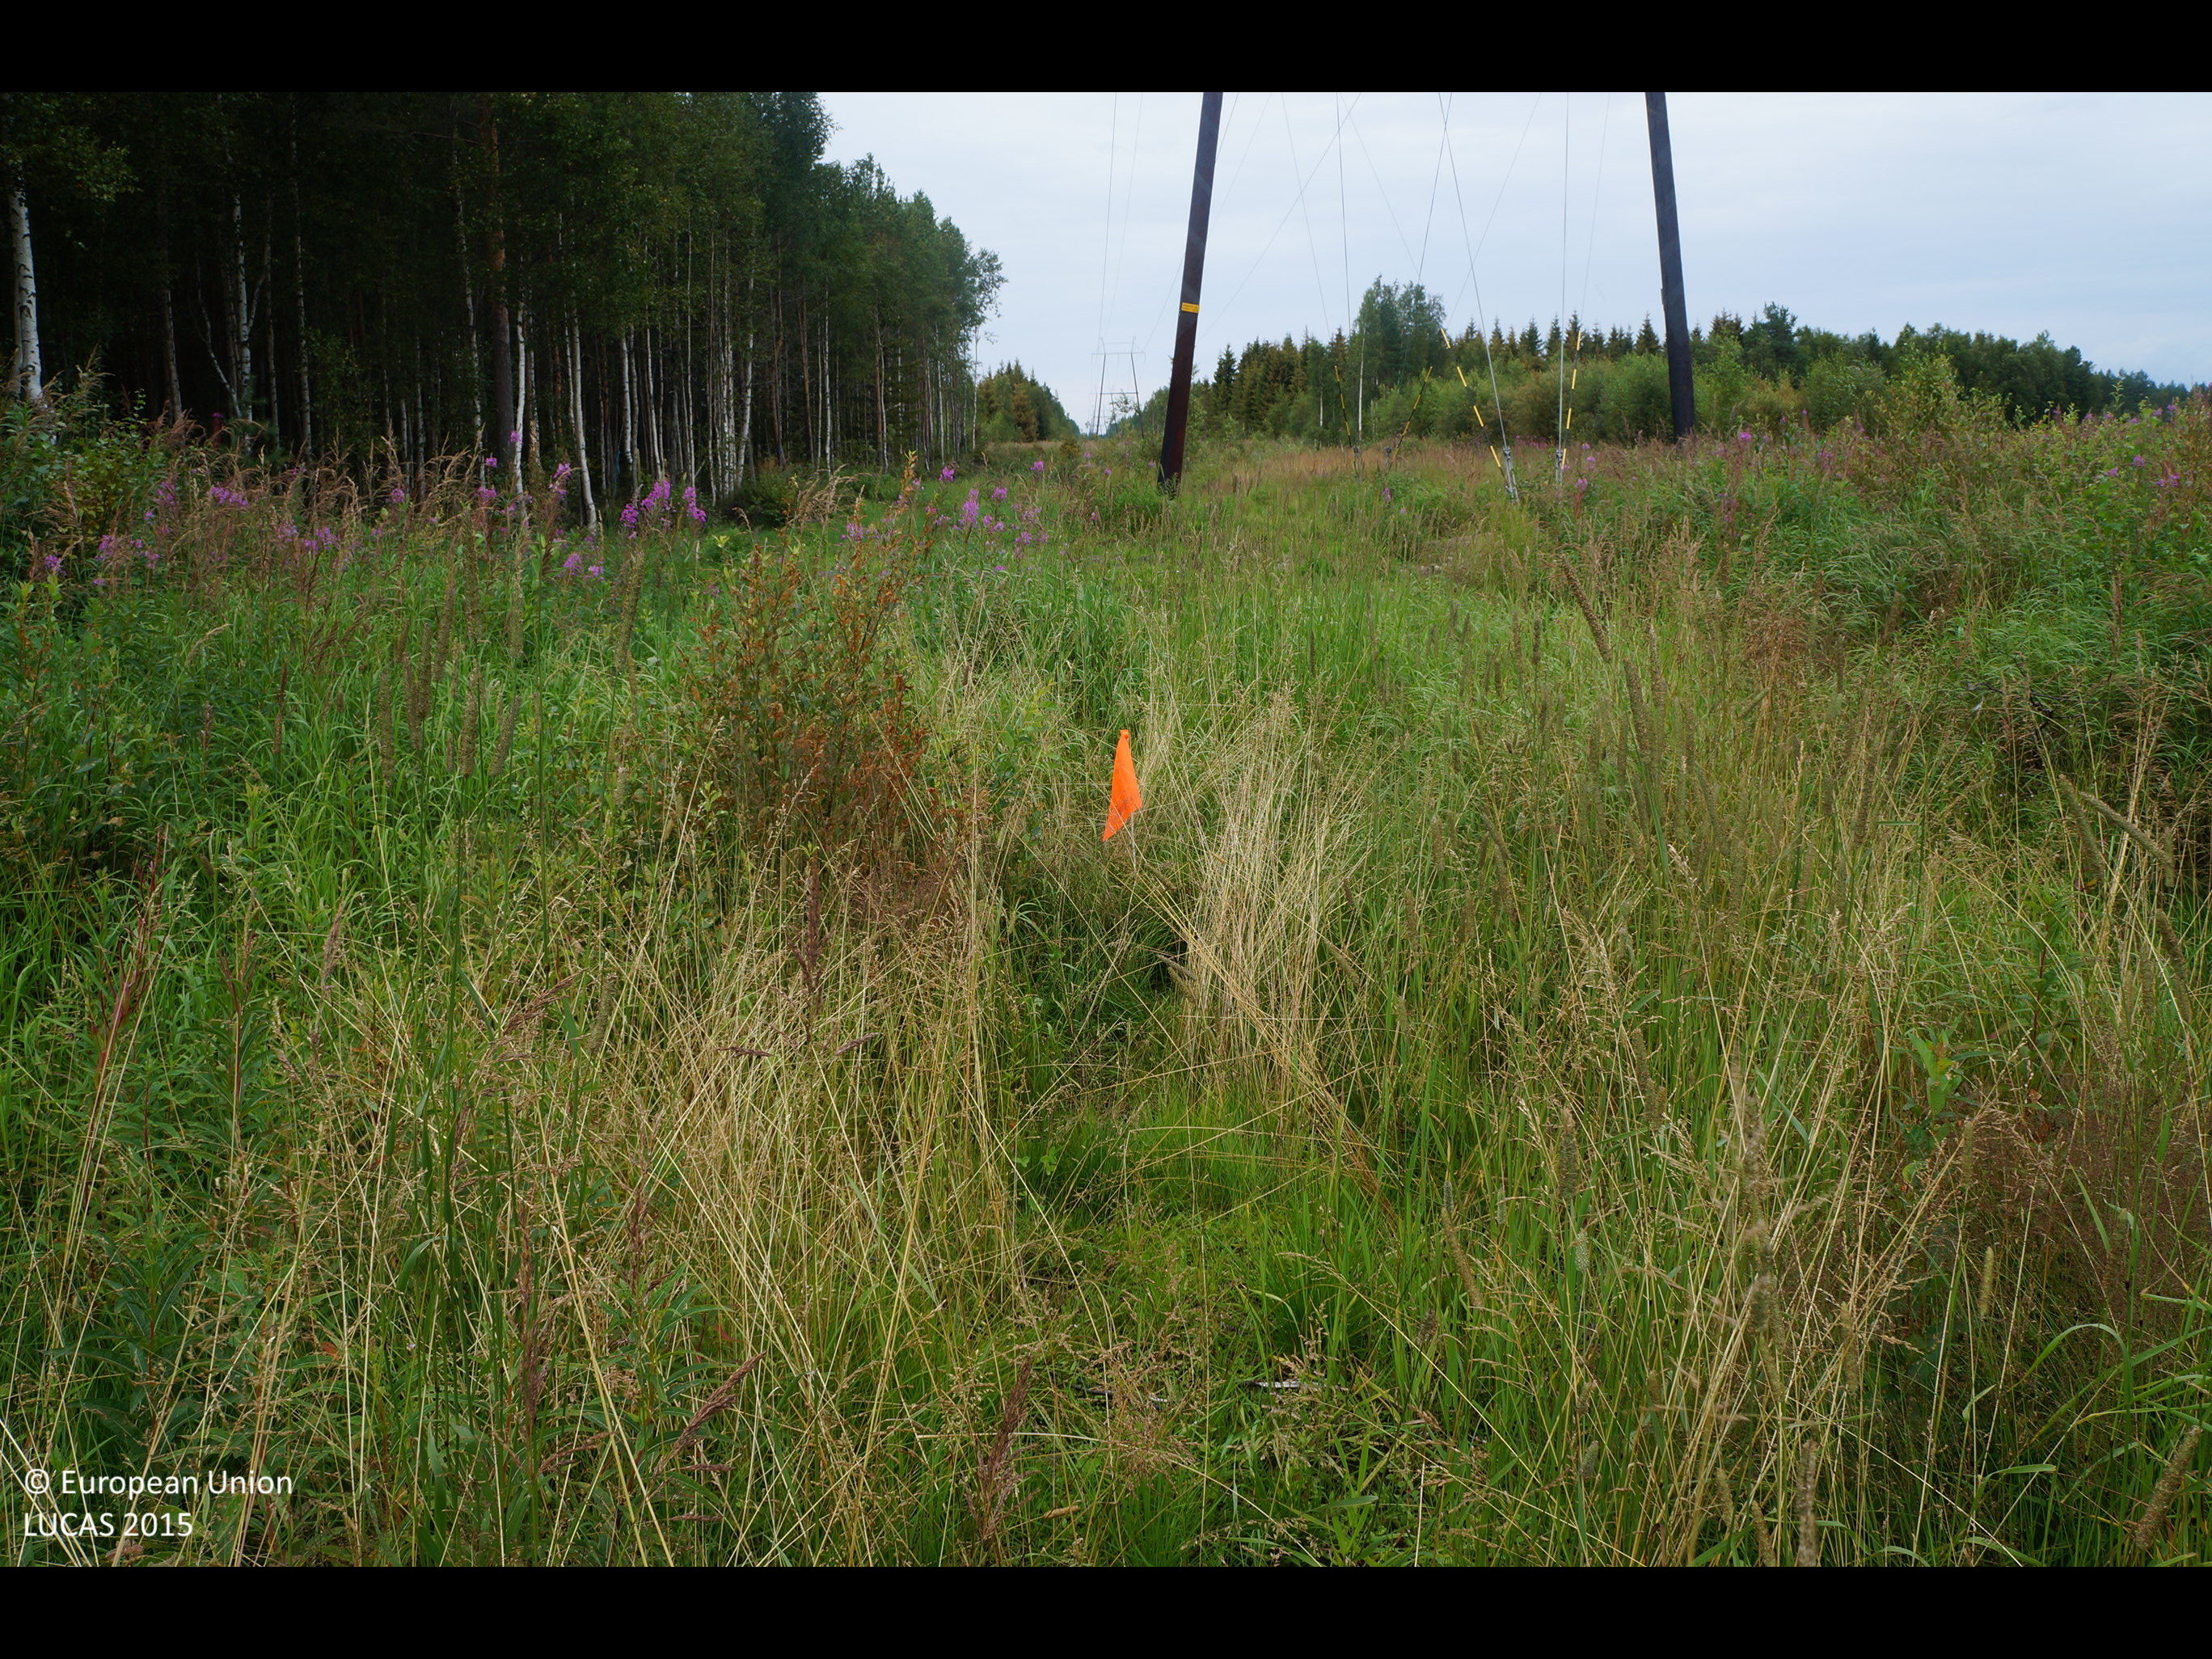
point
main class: Grassland
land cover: Grassland without tree/shrub cover
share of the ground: > 75 %
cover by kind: herbaceous plants 95 %, shrubs 5 %
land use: Electricity, gas and thermal power distribution
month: August
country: FI
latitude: 64.7528
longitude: 24.9736
